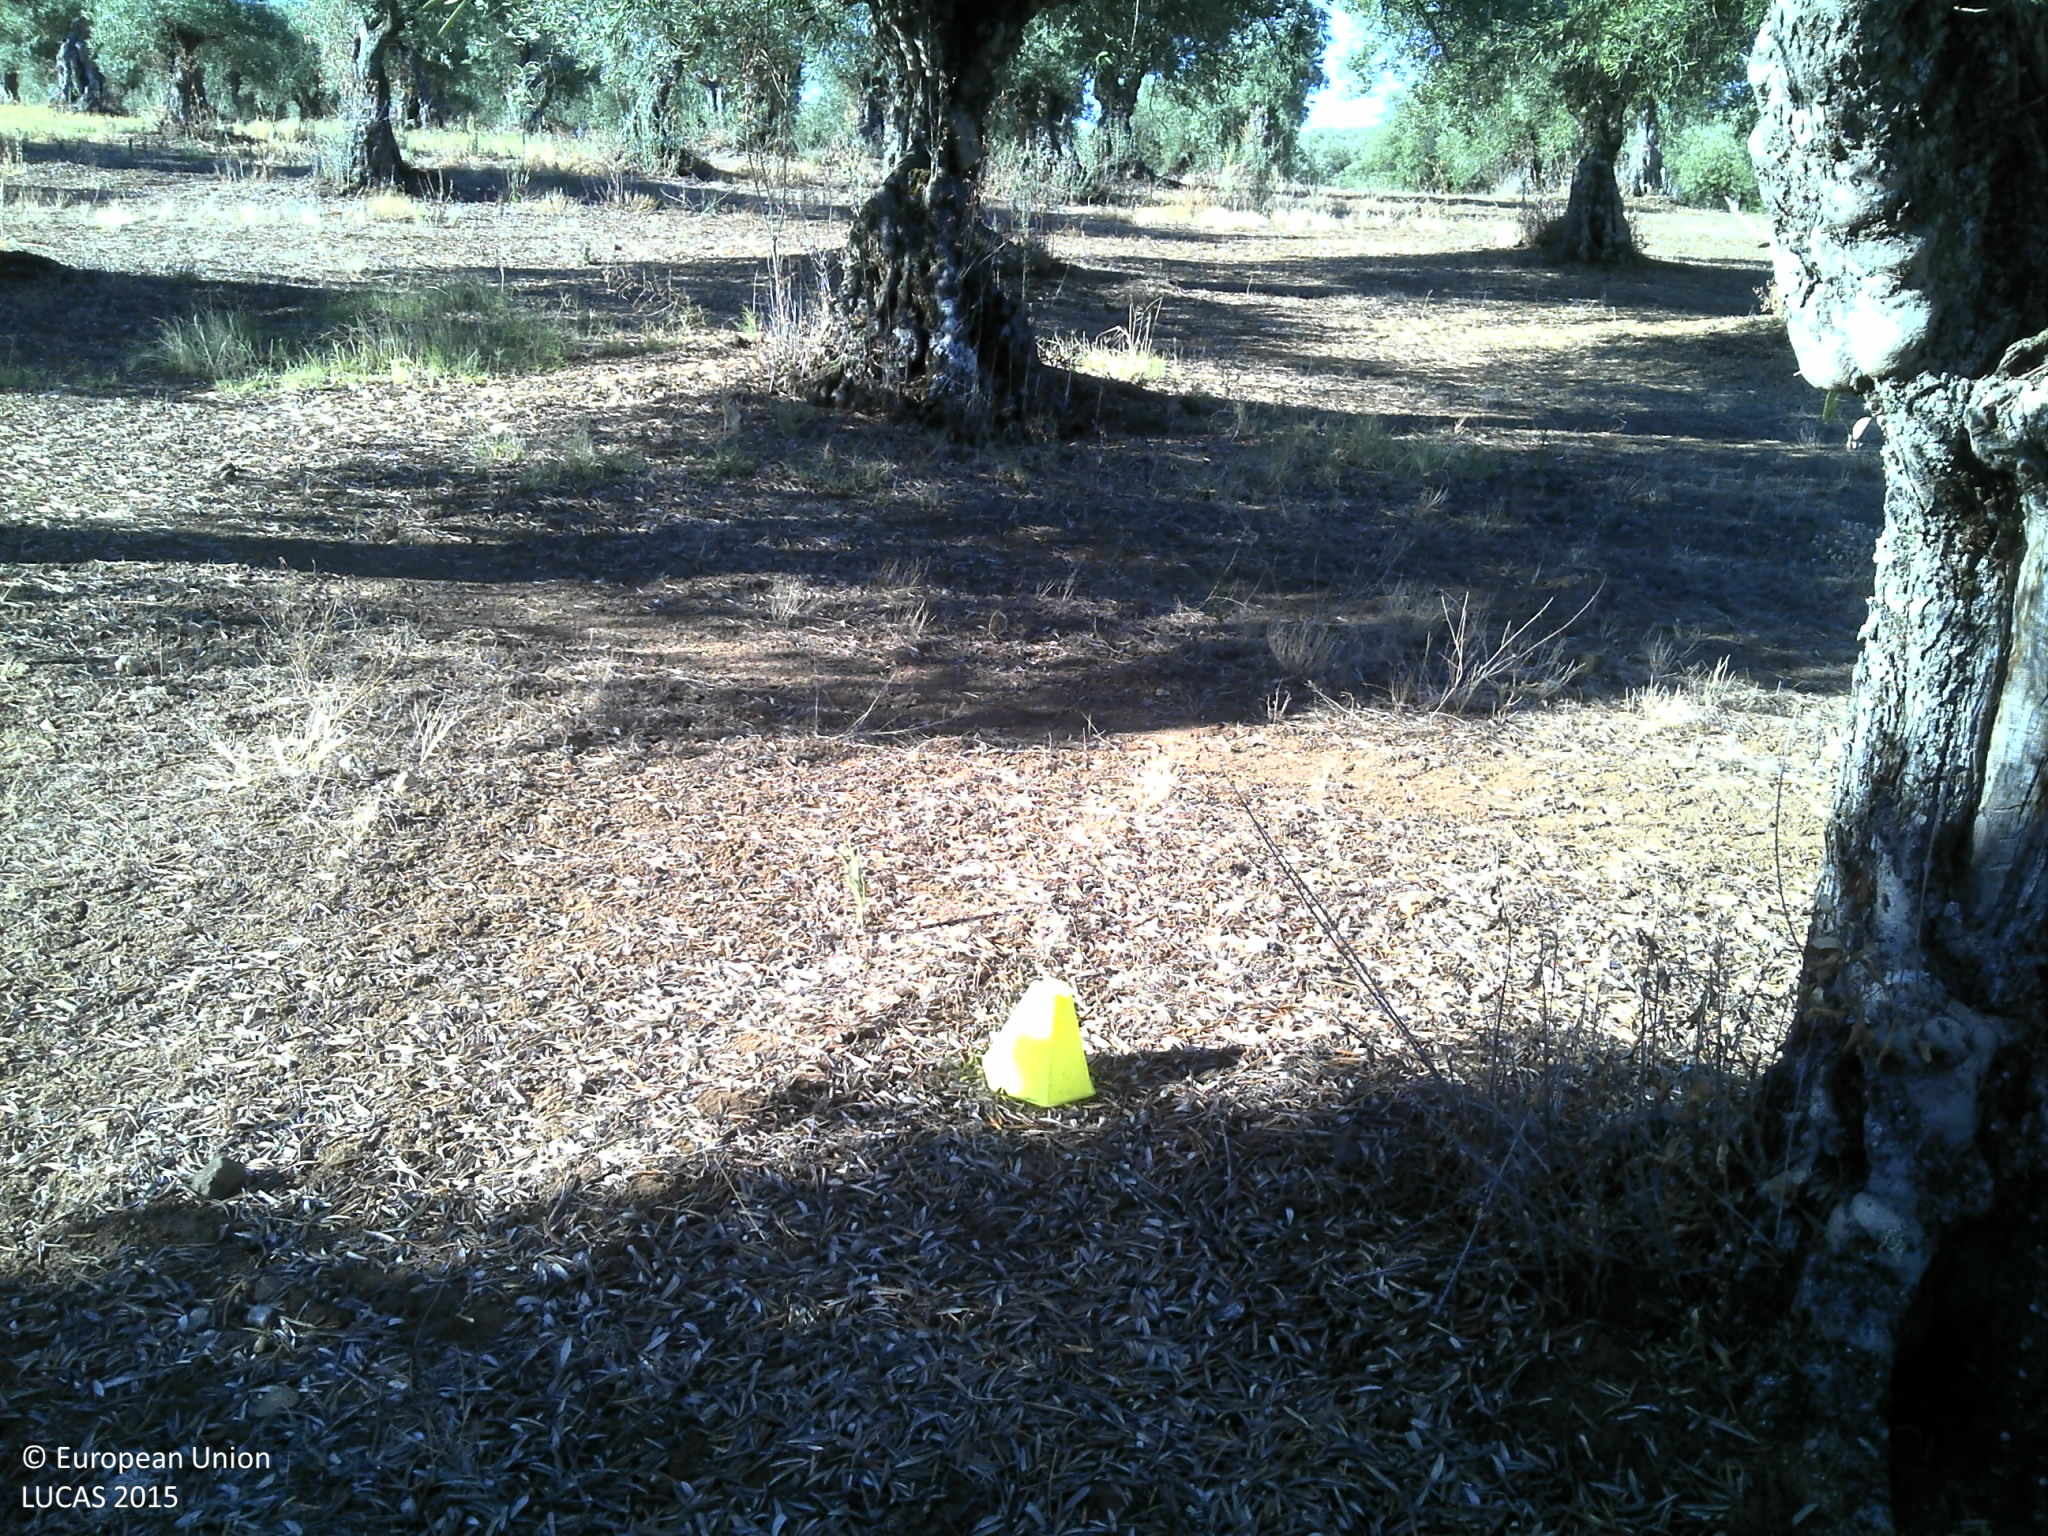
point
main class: Cropland
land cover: Olive groves
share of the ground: 25 - 50 %
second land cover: Grassland without tree/shrub cover
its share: < 10 %
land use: Agriculture (excluding fallow land and kitchen gardens)
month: July
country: PT
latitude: 39.0262
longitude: -7.0188
